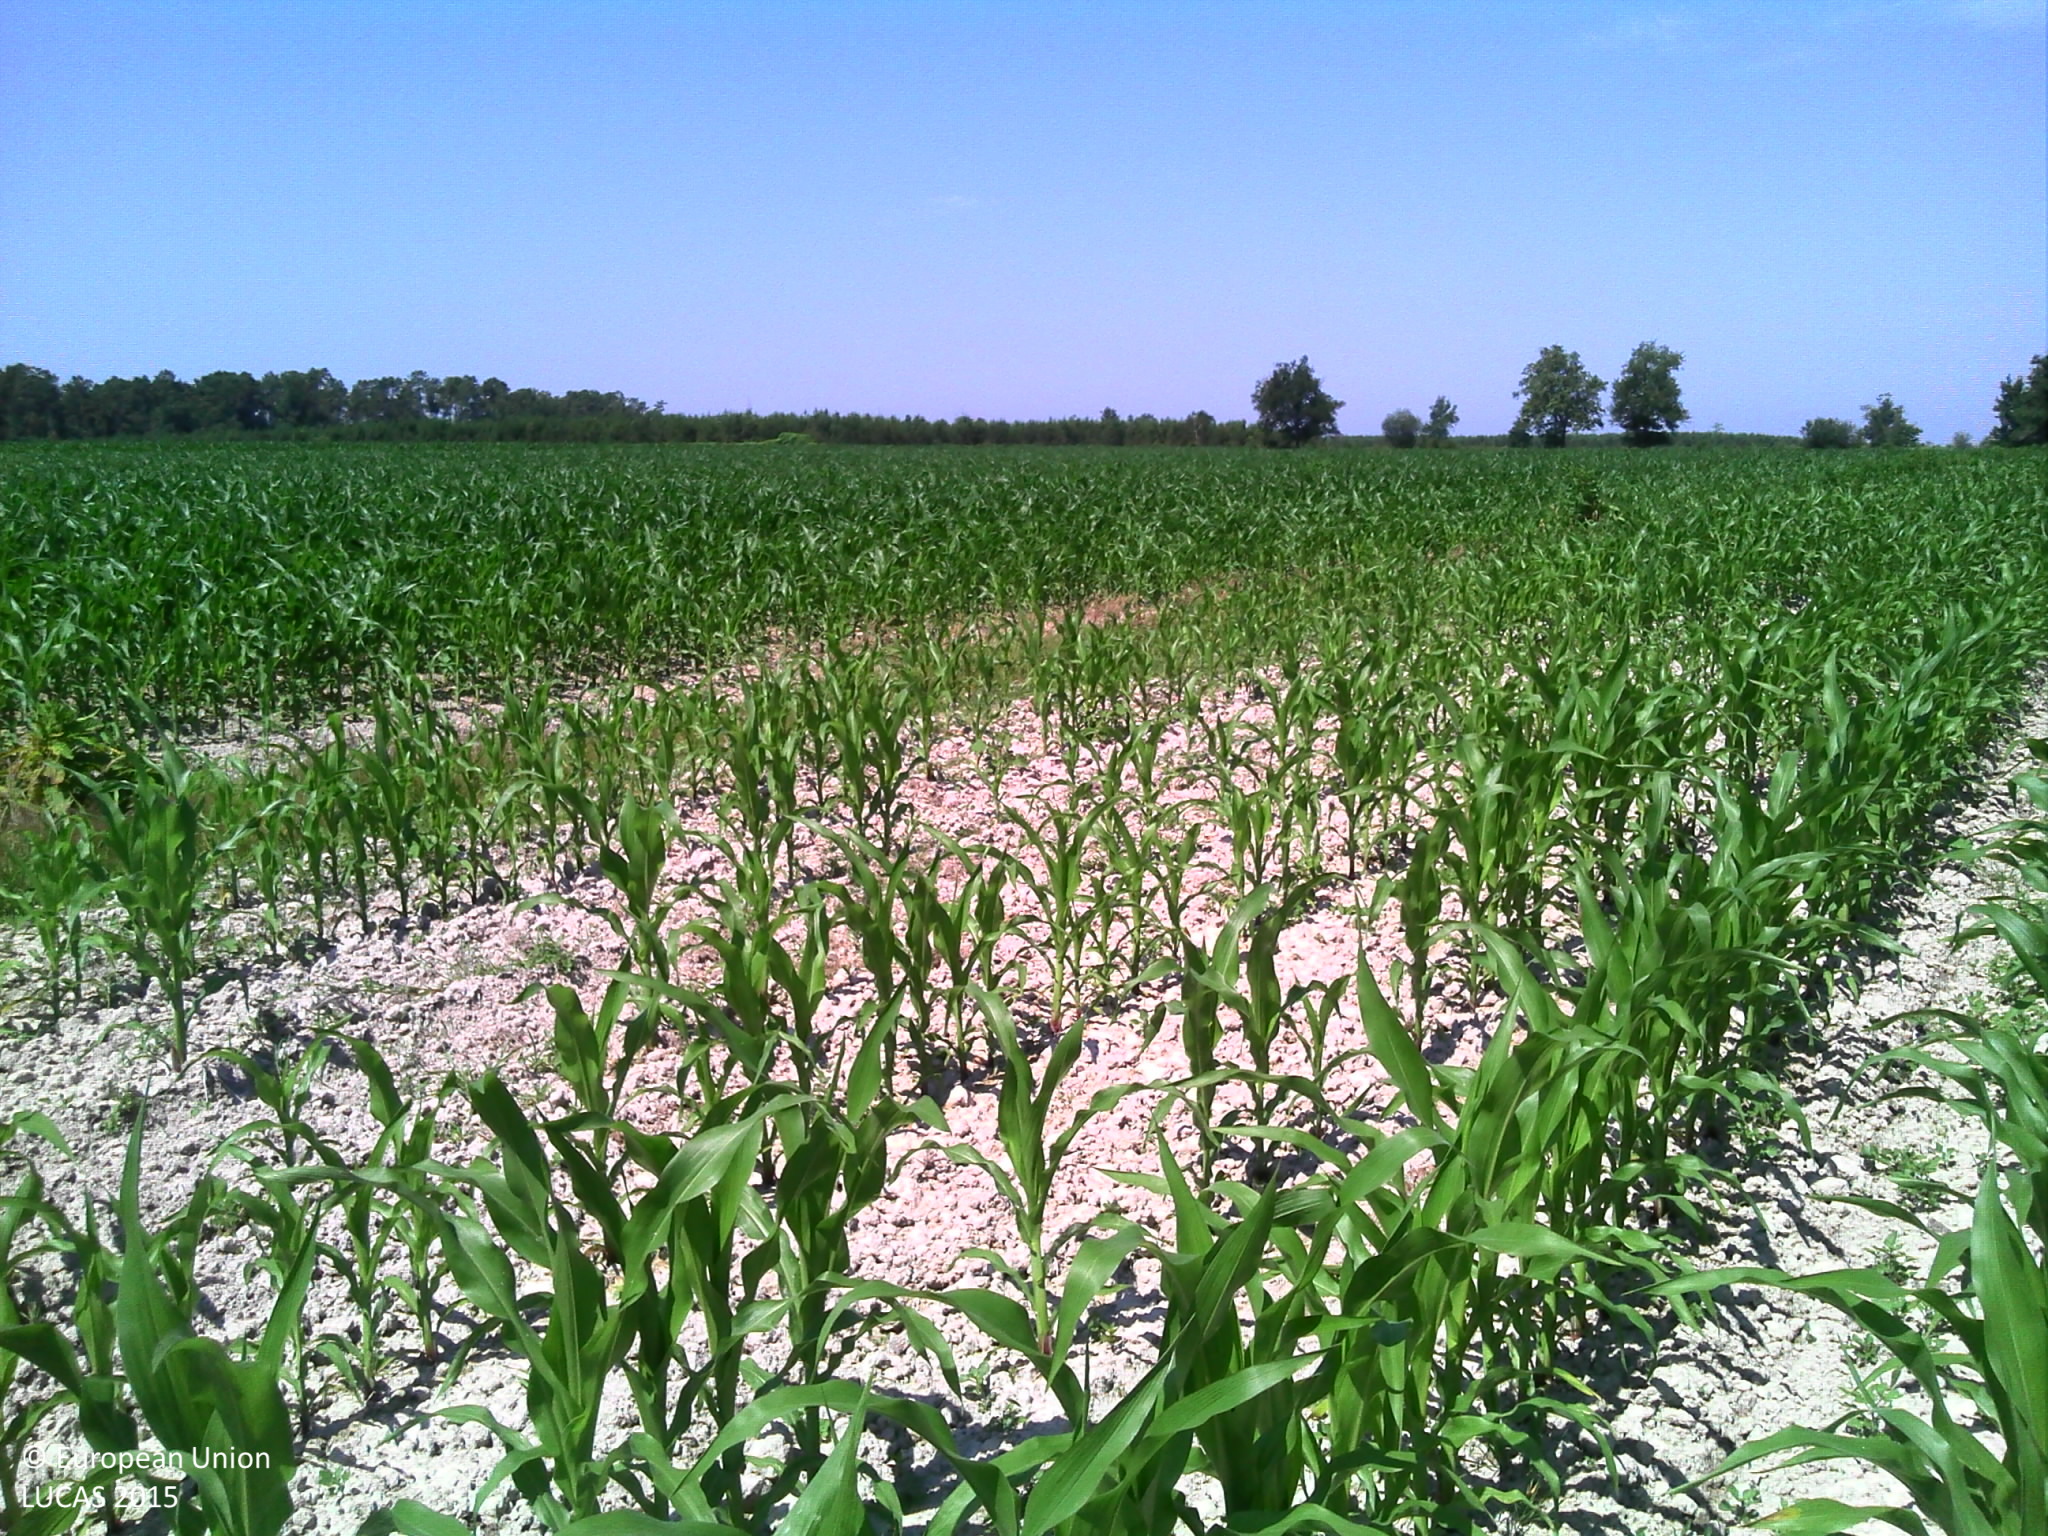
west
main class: Cropland
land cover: Maize
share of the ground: 50 - 75 %
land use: Agriculture (excluding fallow land and kitchen gardens)
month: June
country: FR
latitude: 43.6312
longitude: -0.5332
